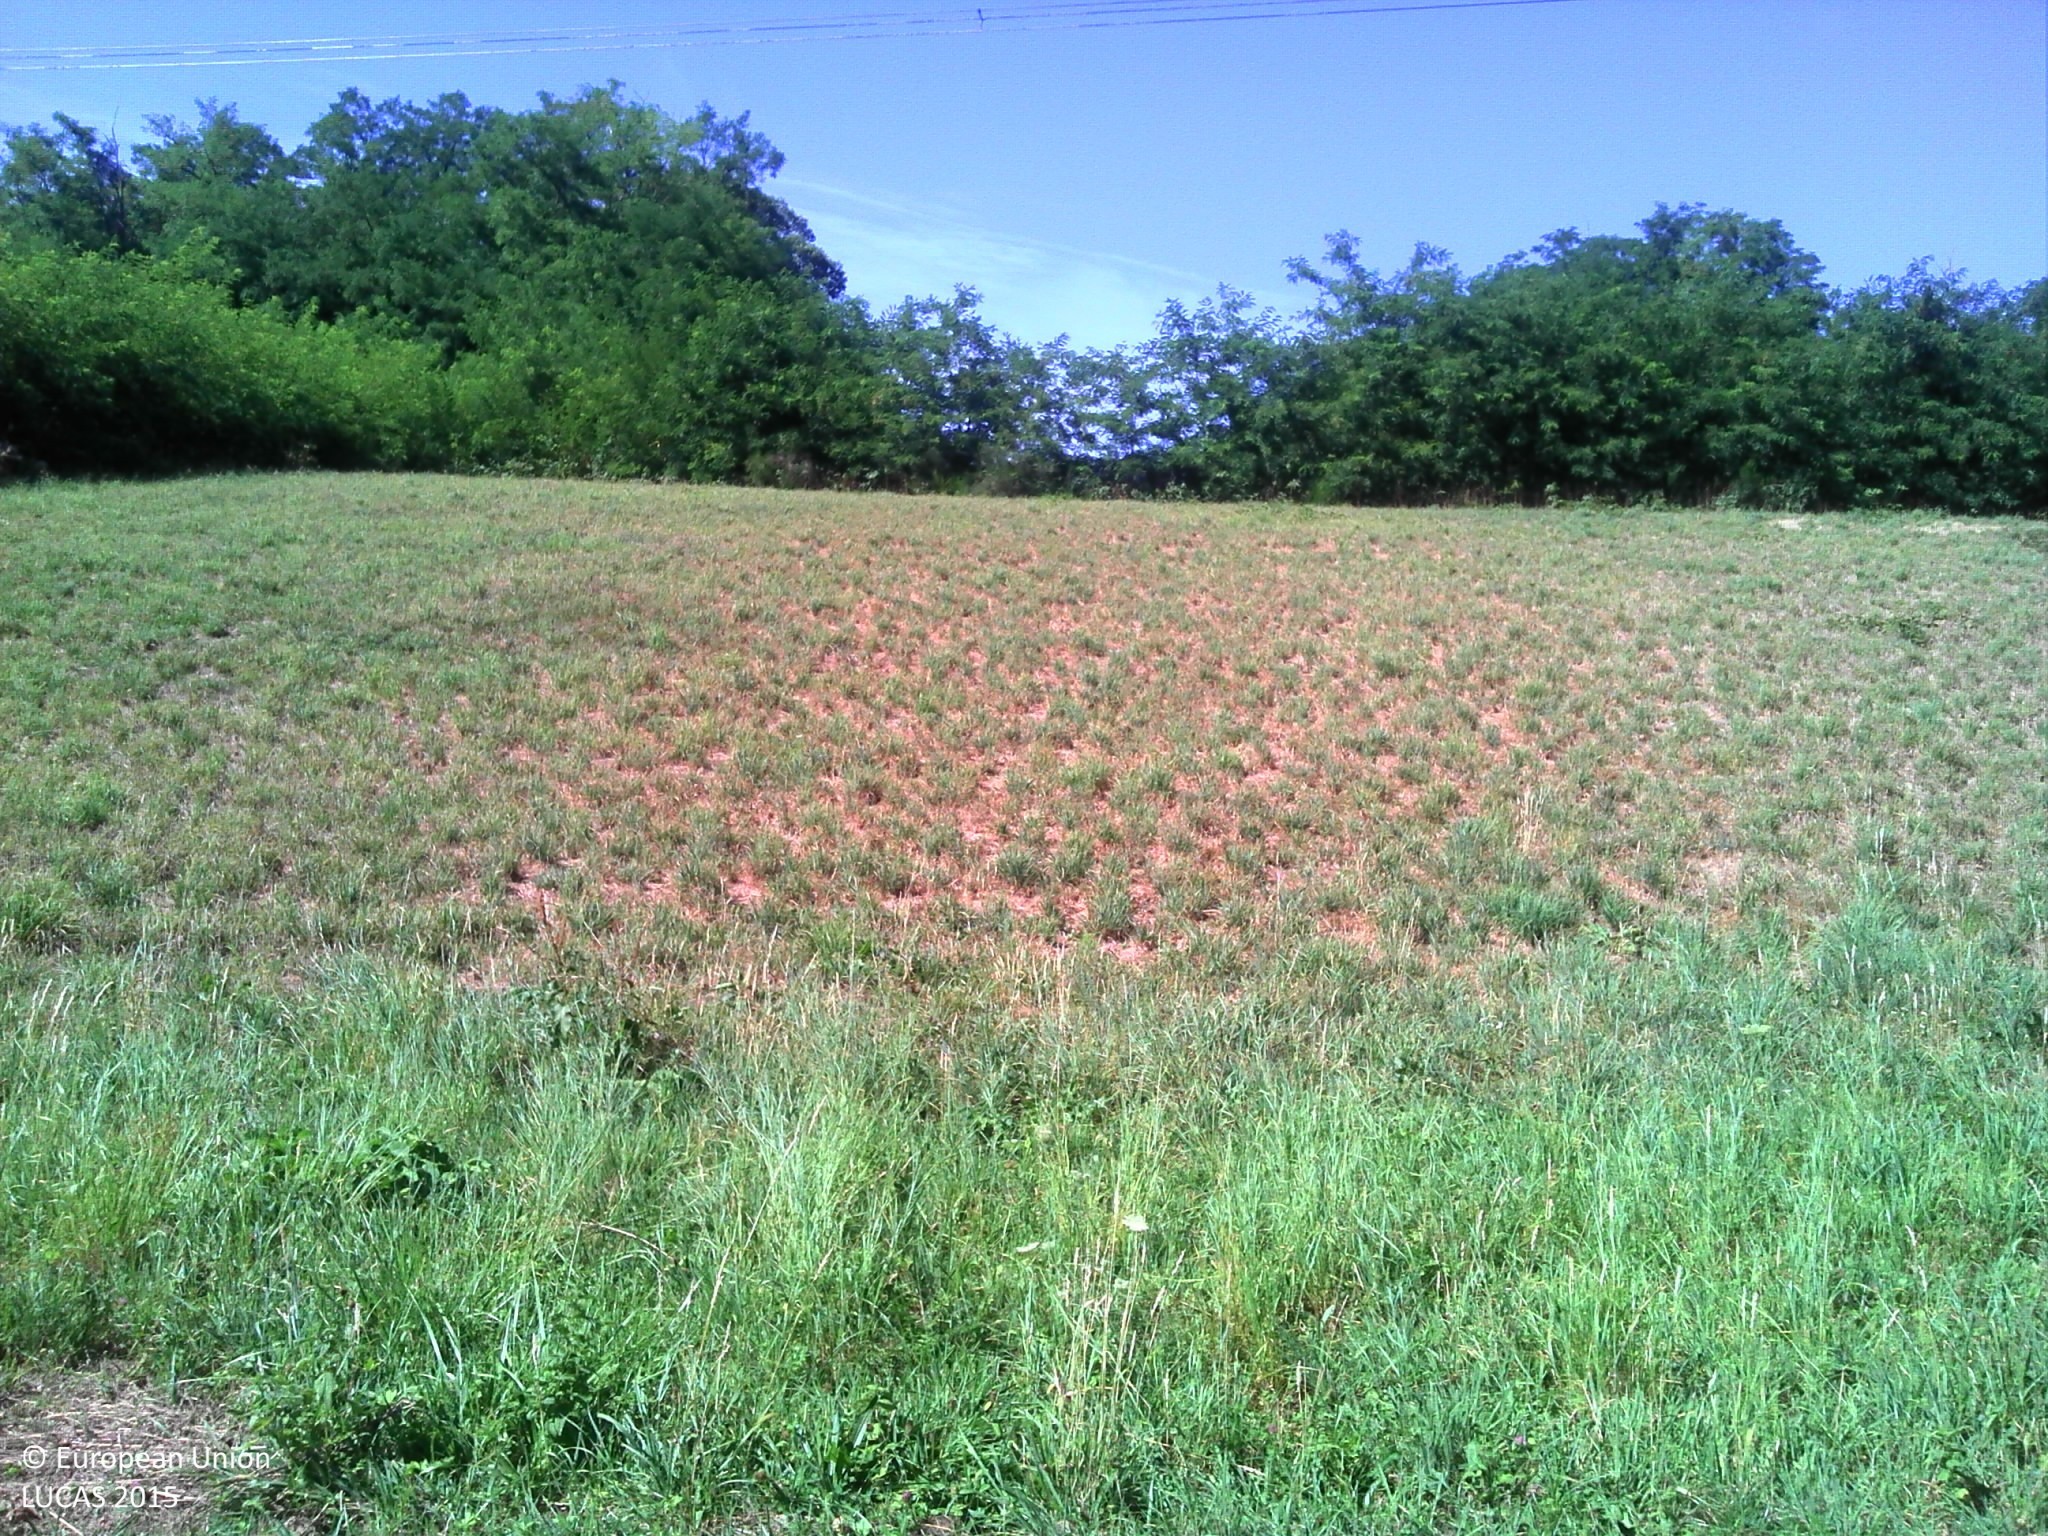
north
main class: Grassland
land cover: Grassland without tree/shrub cover
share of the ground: > 75 %
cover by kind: herbaceous plants 100 %
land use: Agriculture (excluding fallow land and kitchen gardens)
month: July
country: FR
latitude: 45.6050
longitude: 5.4528
